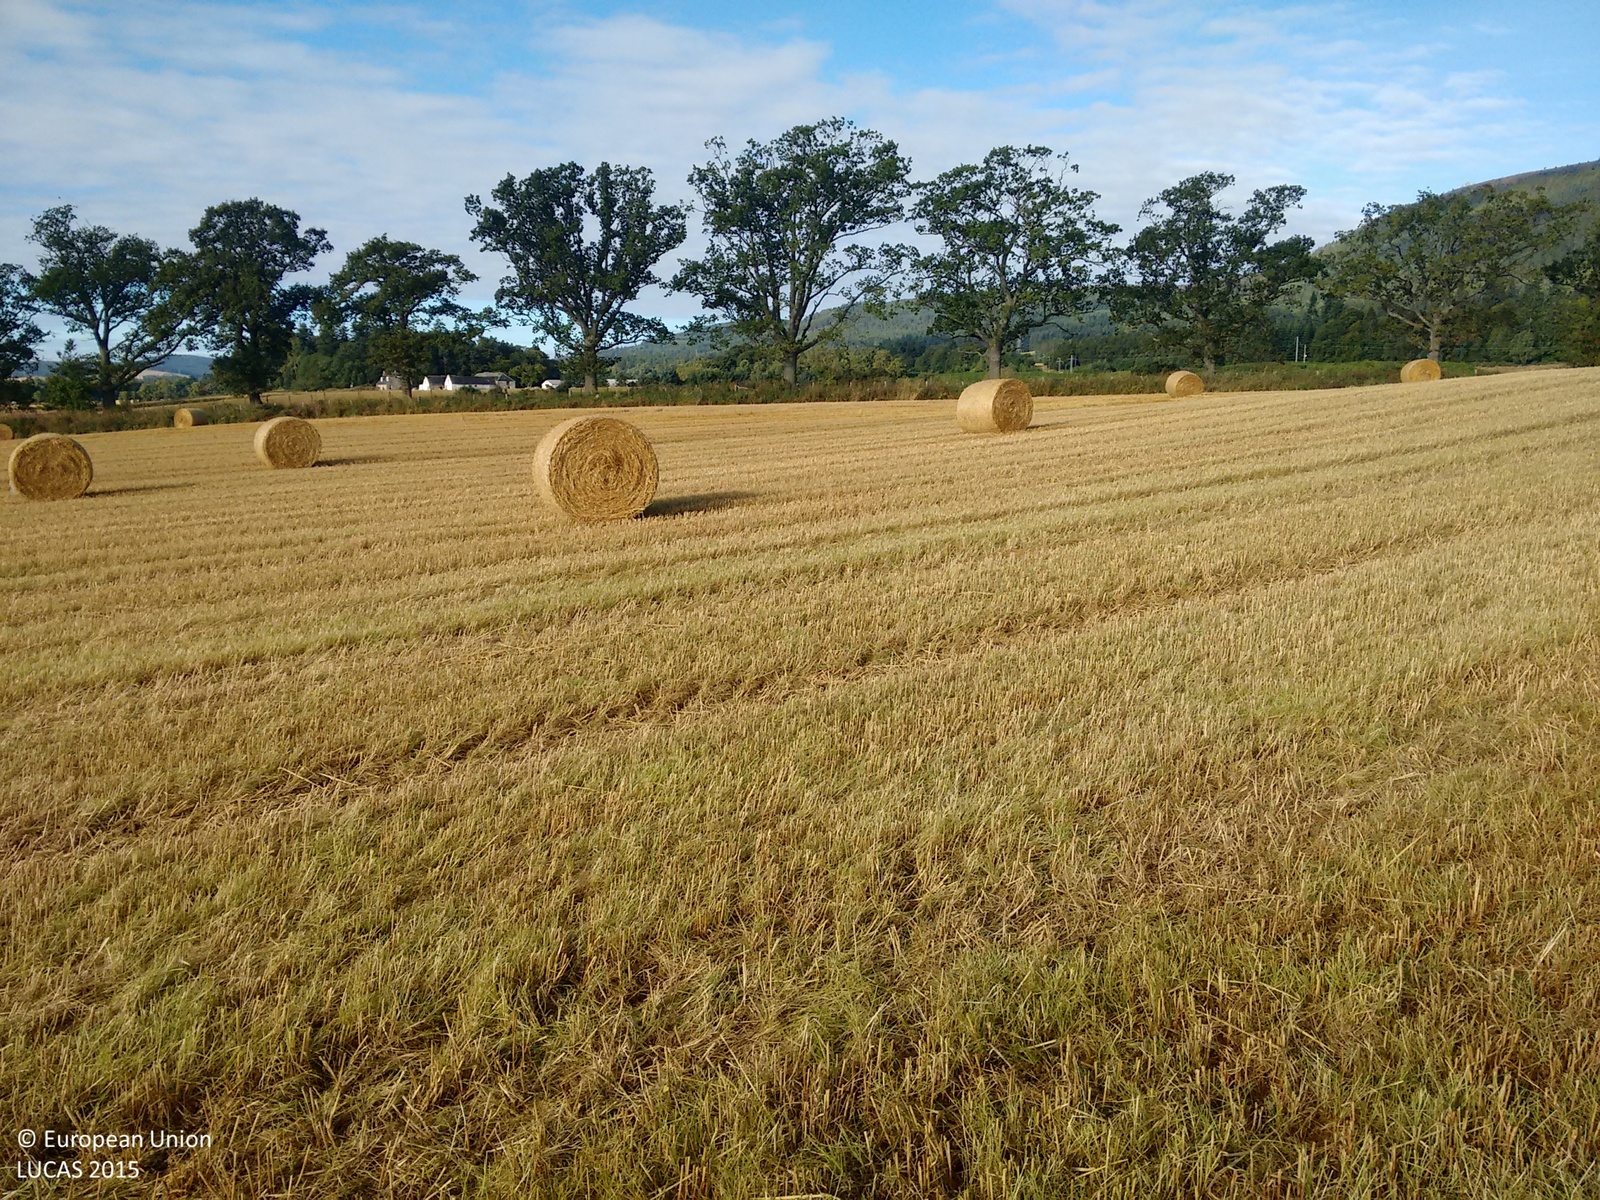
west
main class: Cropland
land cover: Common wheat
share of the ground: > 75 %
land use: Agriculture (excluding fallow land and kitchen gardens)
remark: Harvested field
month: September
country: GB
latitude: 57.6880
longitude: -4.2927
